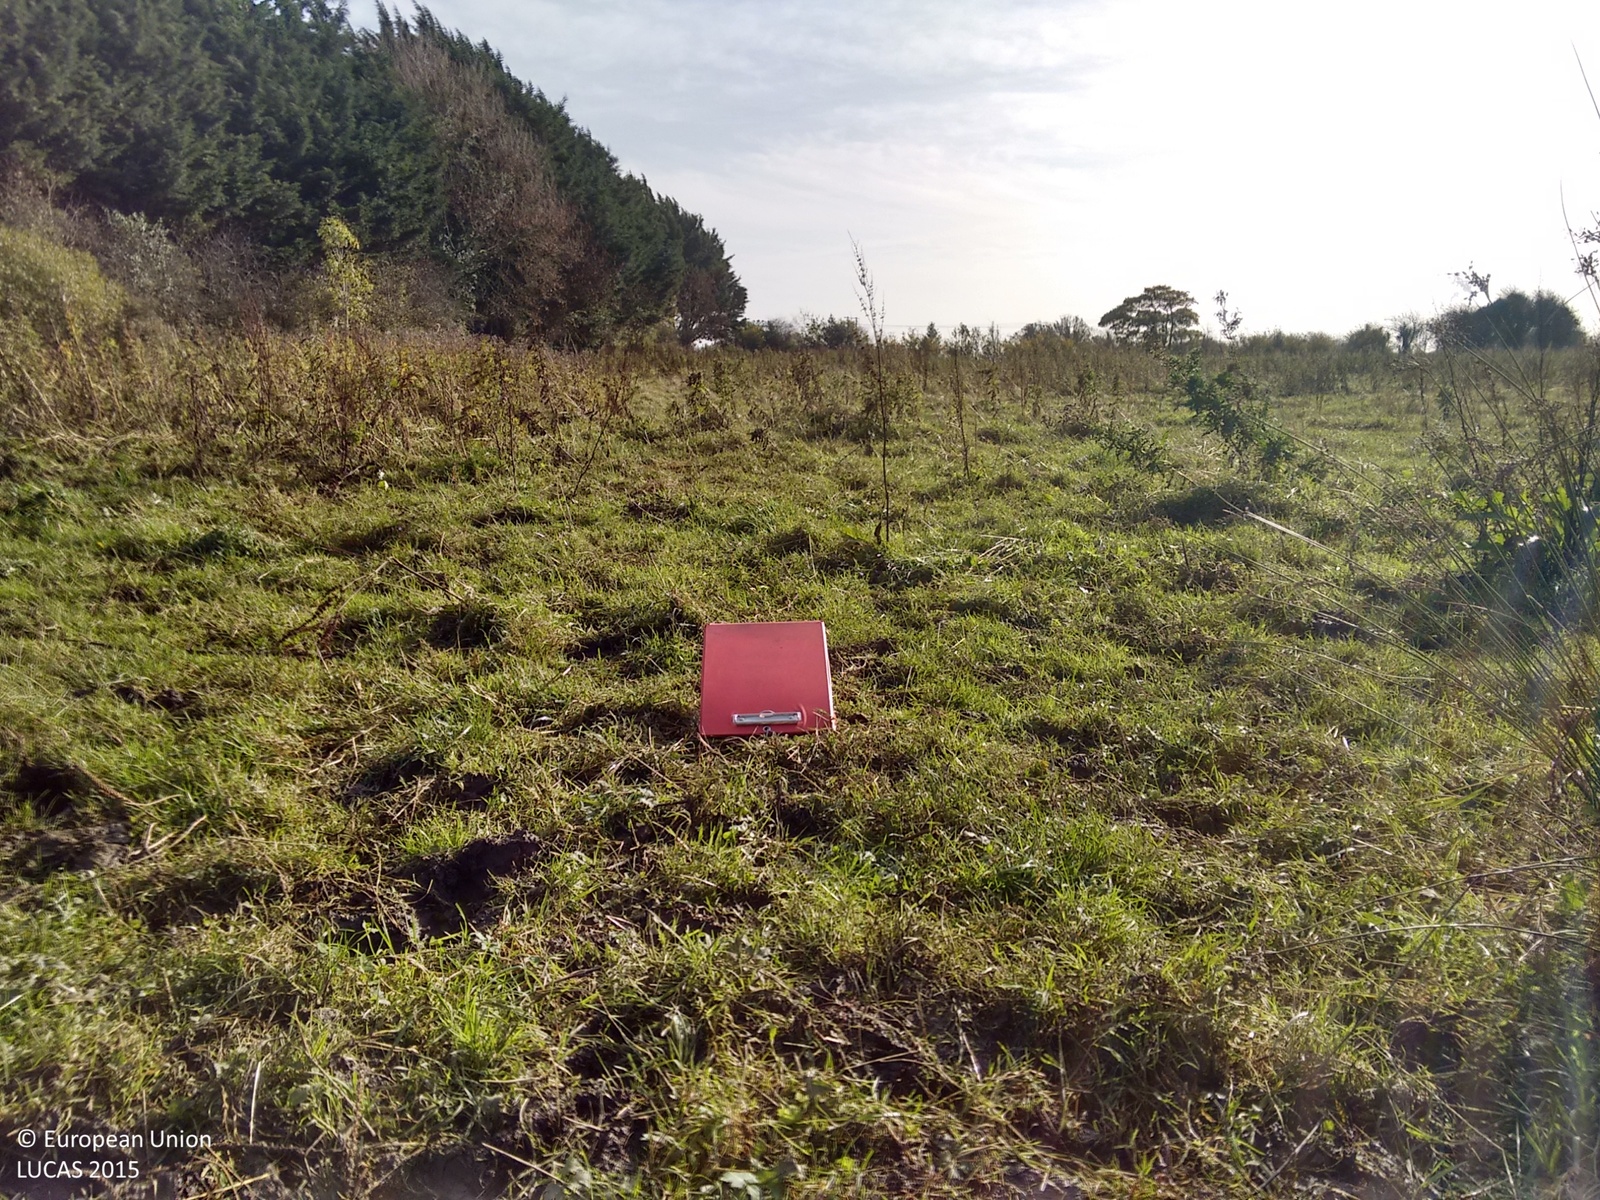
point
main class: Grassland
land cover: Grassland without tree/shrub cover
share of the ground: > 75 %
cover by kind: herbaceous plants 95 %, shrubs 5 %
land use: Agriculture (excluding fallow land and kitchen gardens)
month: October
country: IE
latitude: 53.2247
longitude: -7.8292
